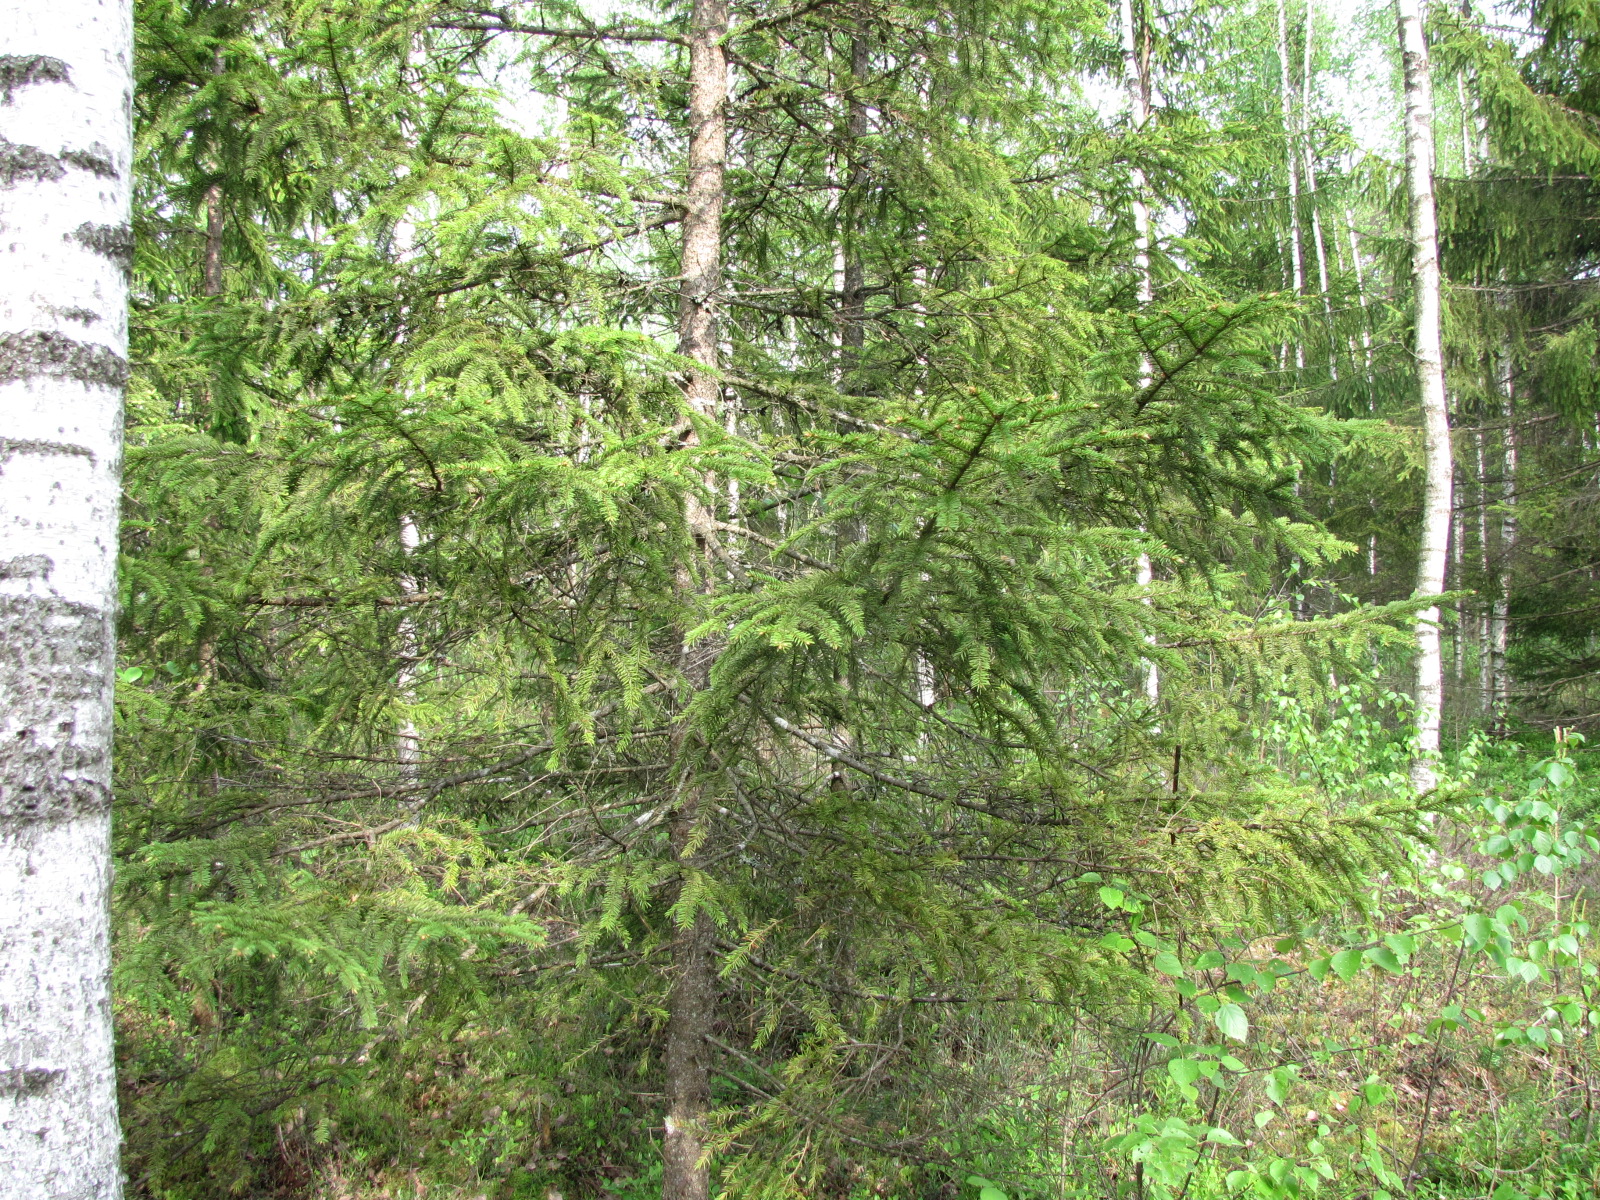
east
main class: Woodland
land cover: Spruce dominated mixed woodland
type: hemiboreal forest and nemoral coniferous forest and mixed broadleaved-coniferous forest
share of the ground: 50 - 75 %
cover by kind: coniferous forest trees 30 %, broadleaved forest trees 30 %, herbaceous plants 20 %, lichens and mosses 20 %
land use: Forestry
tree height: > 5 m
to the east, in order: Spruce dominated mixed woodland; Pine dominated mixed woodland; Pine dominated coniferous woodland
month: June
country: LV
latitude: 56.6442
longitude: 24.2944
